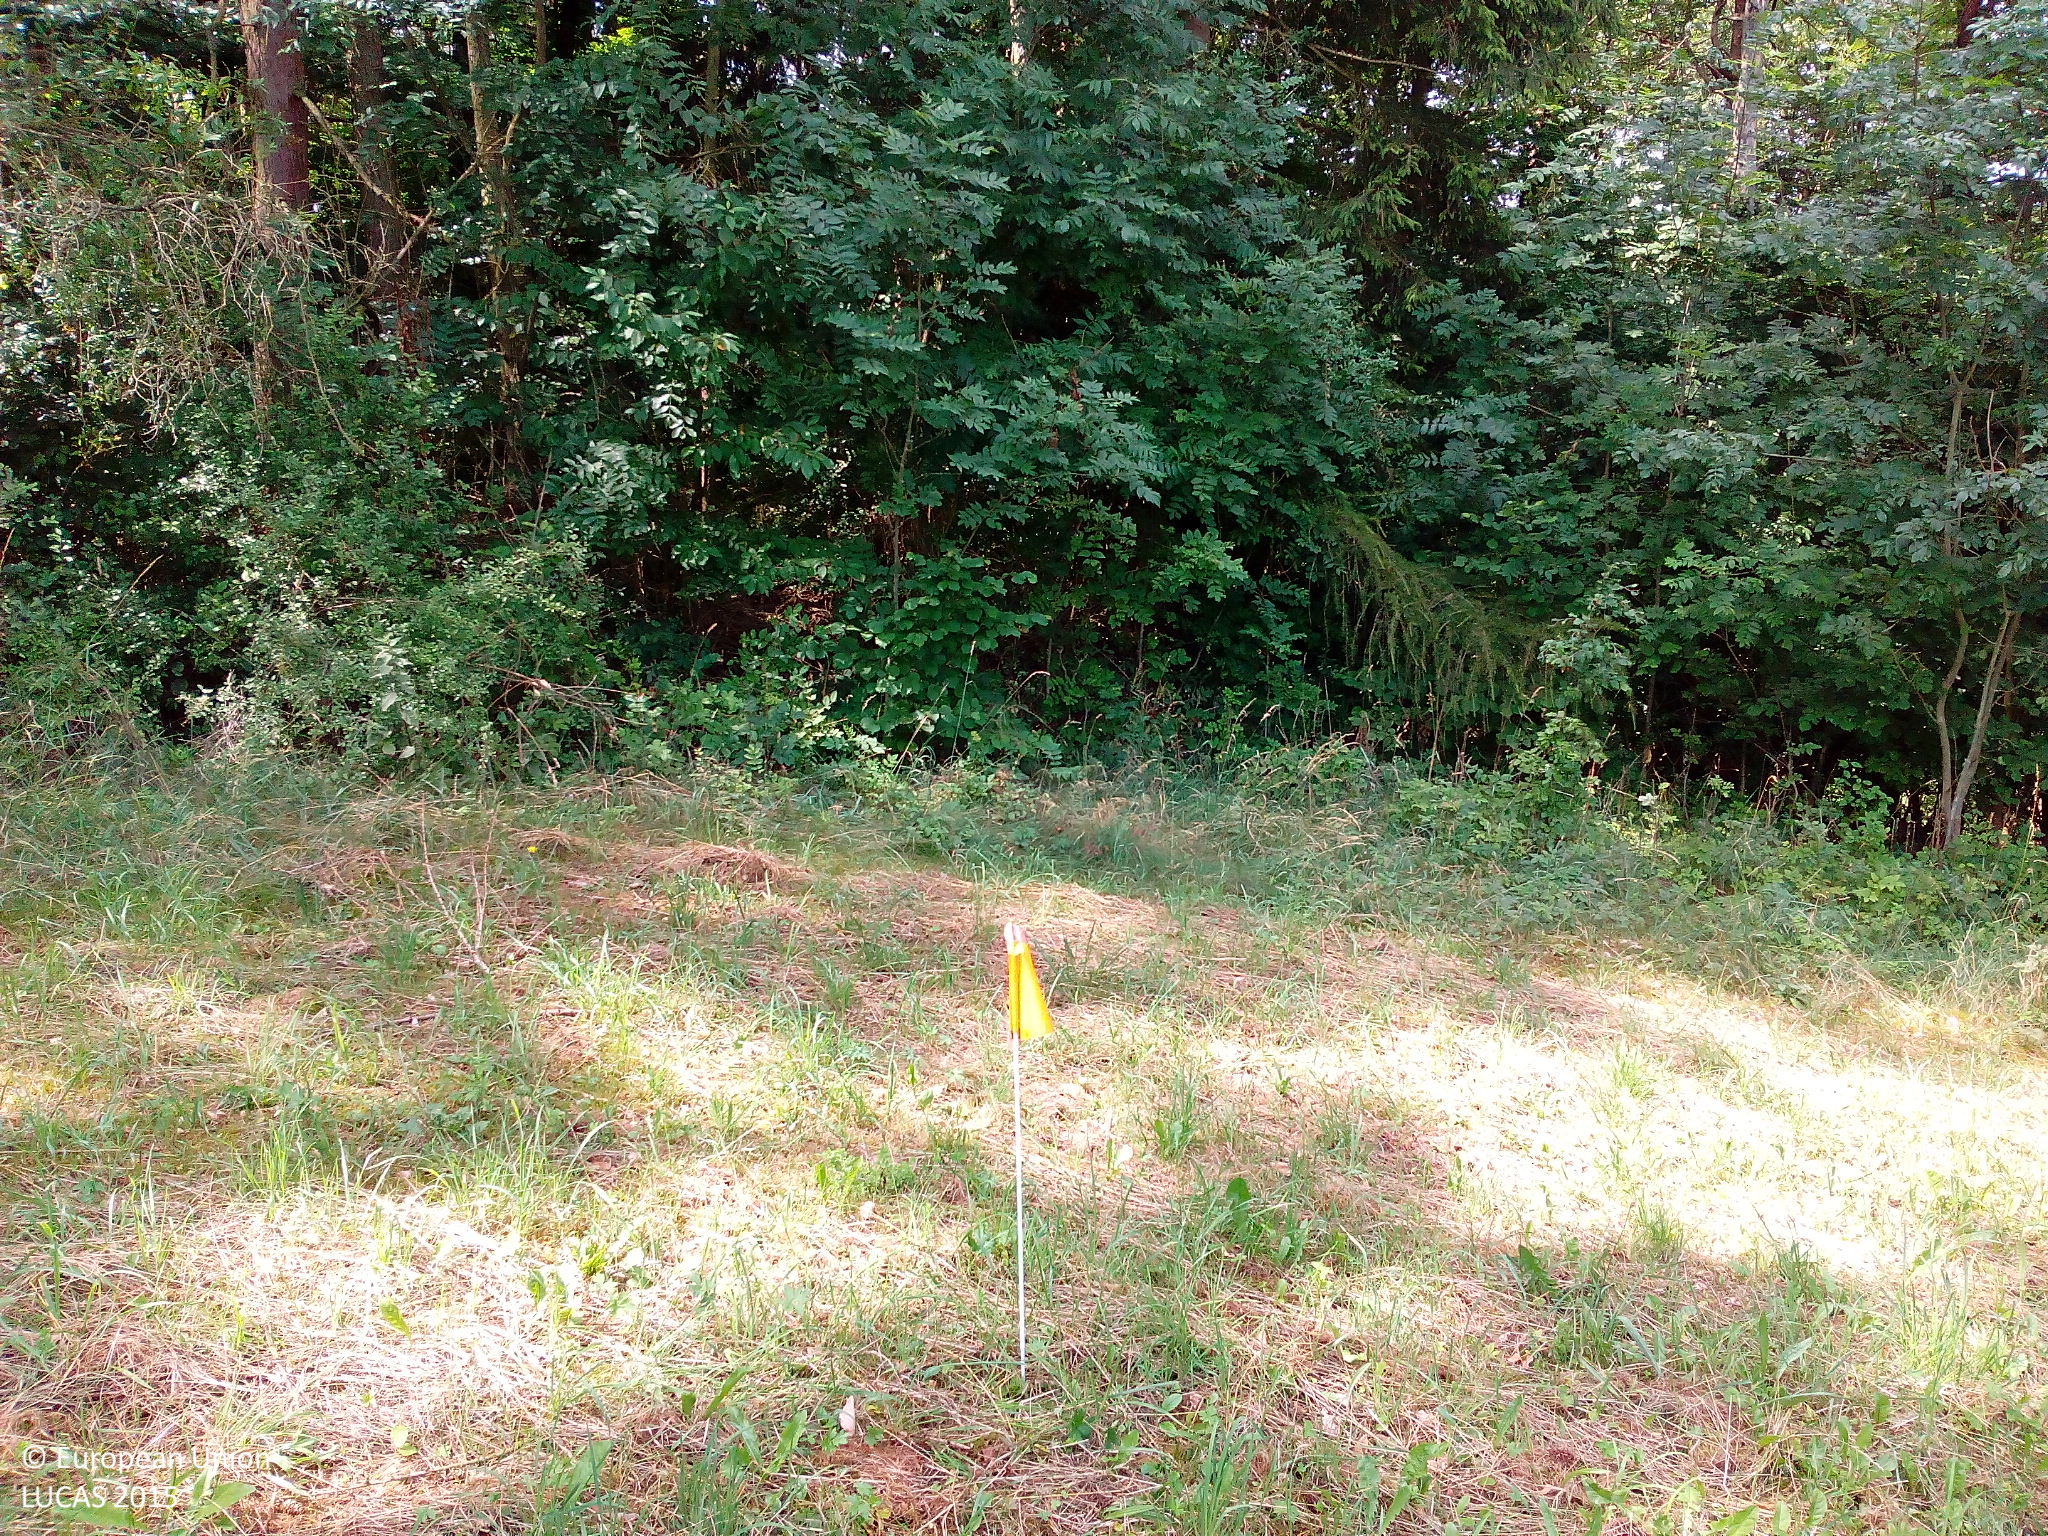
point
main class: Grassland
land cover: Grassland without tree/shrub cover
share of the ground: > 75 %
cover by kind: herbaceous plants 100 %
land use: Agriculture (excluding fallow land and kitchen gardens)
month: July
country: DE
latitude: 50.6697
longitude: 9.9293
